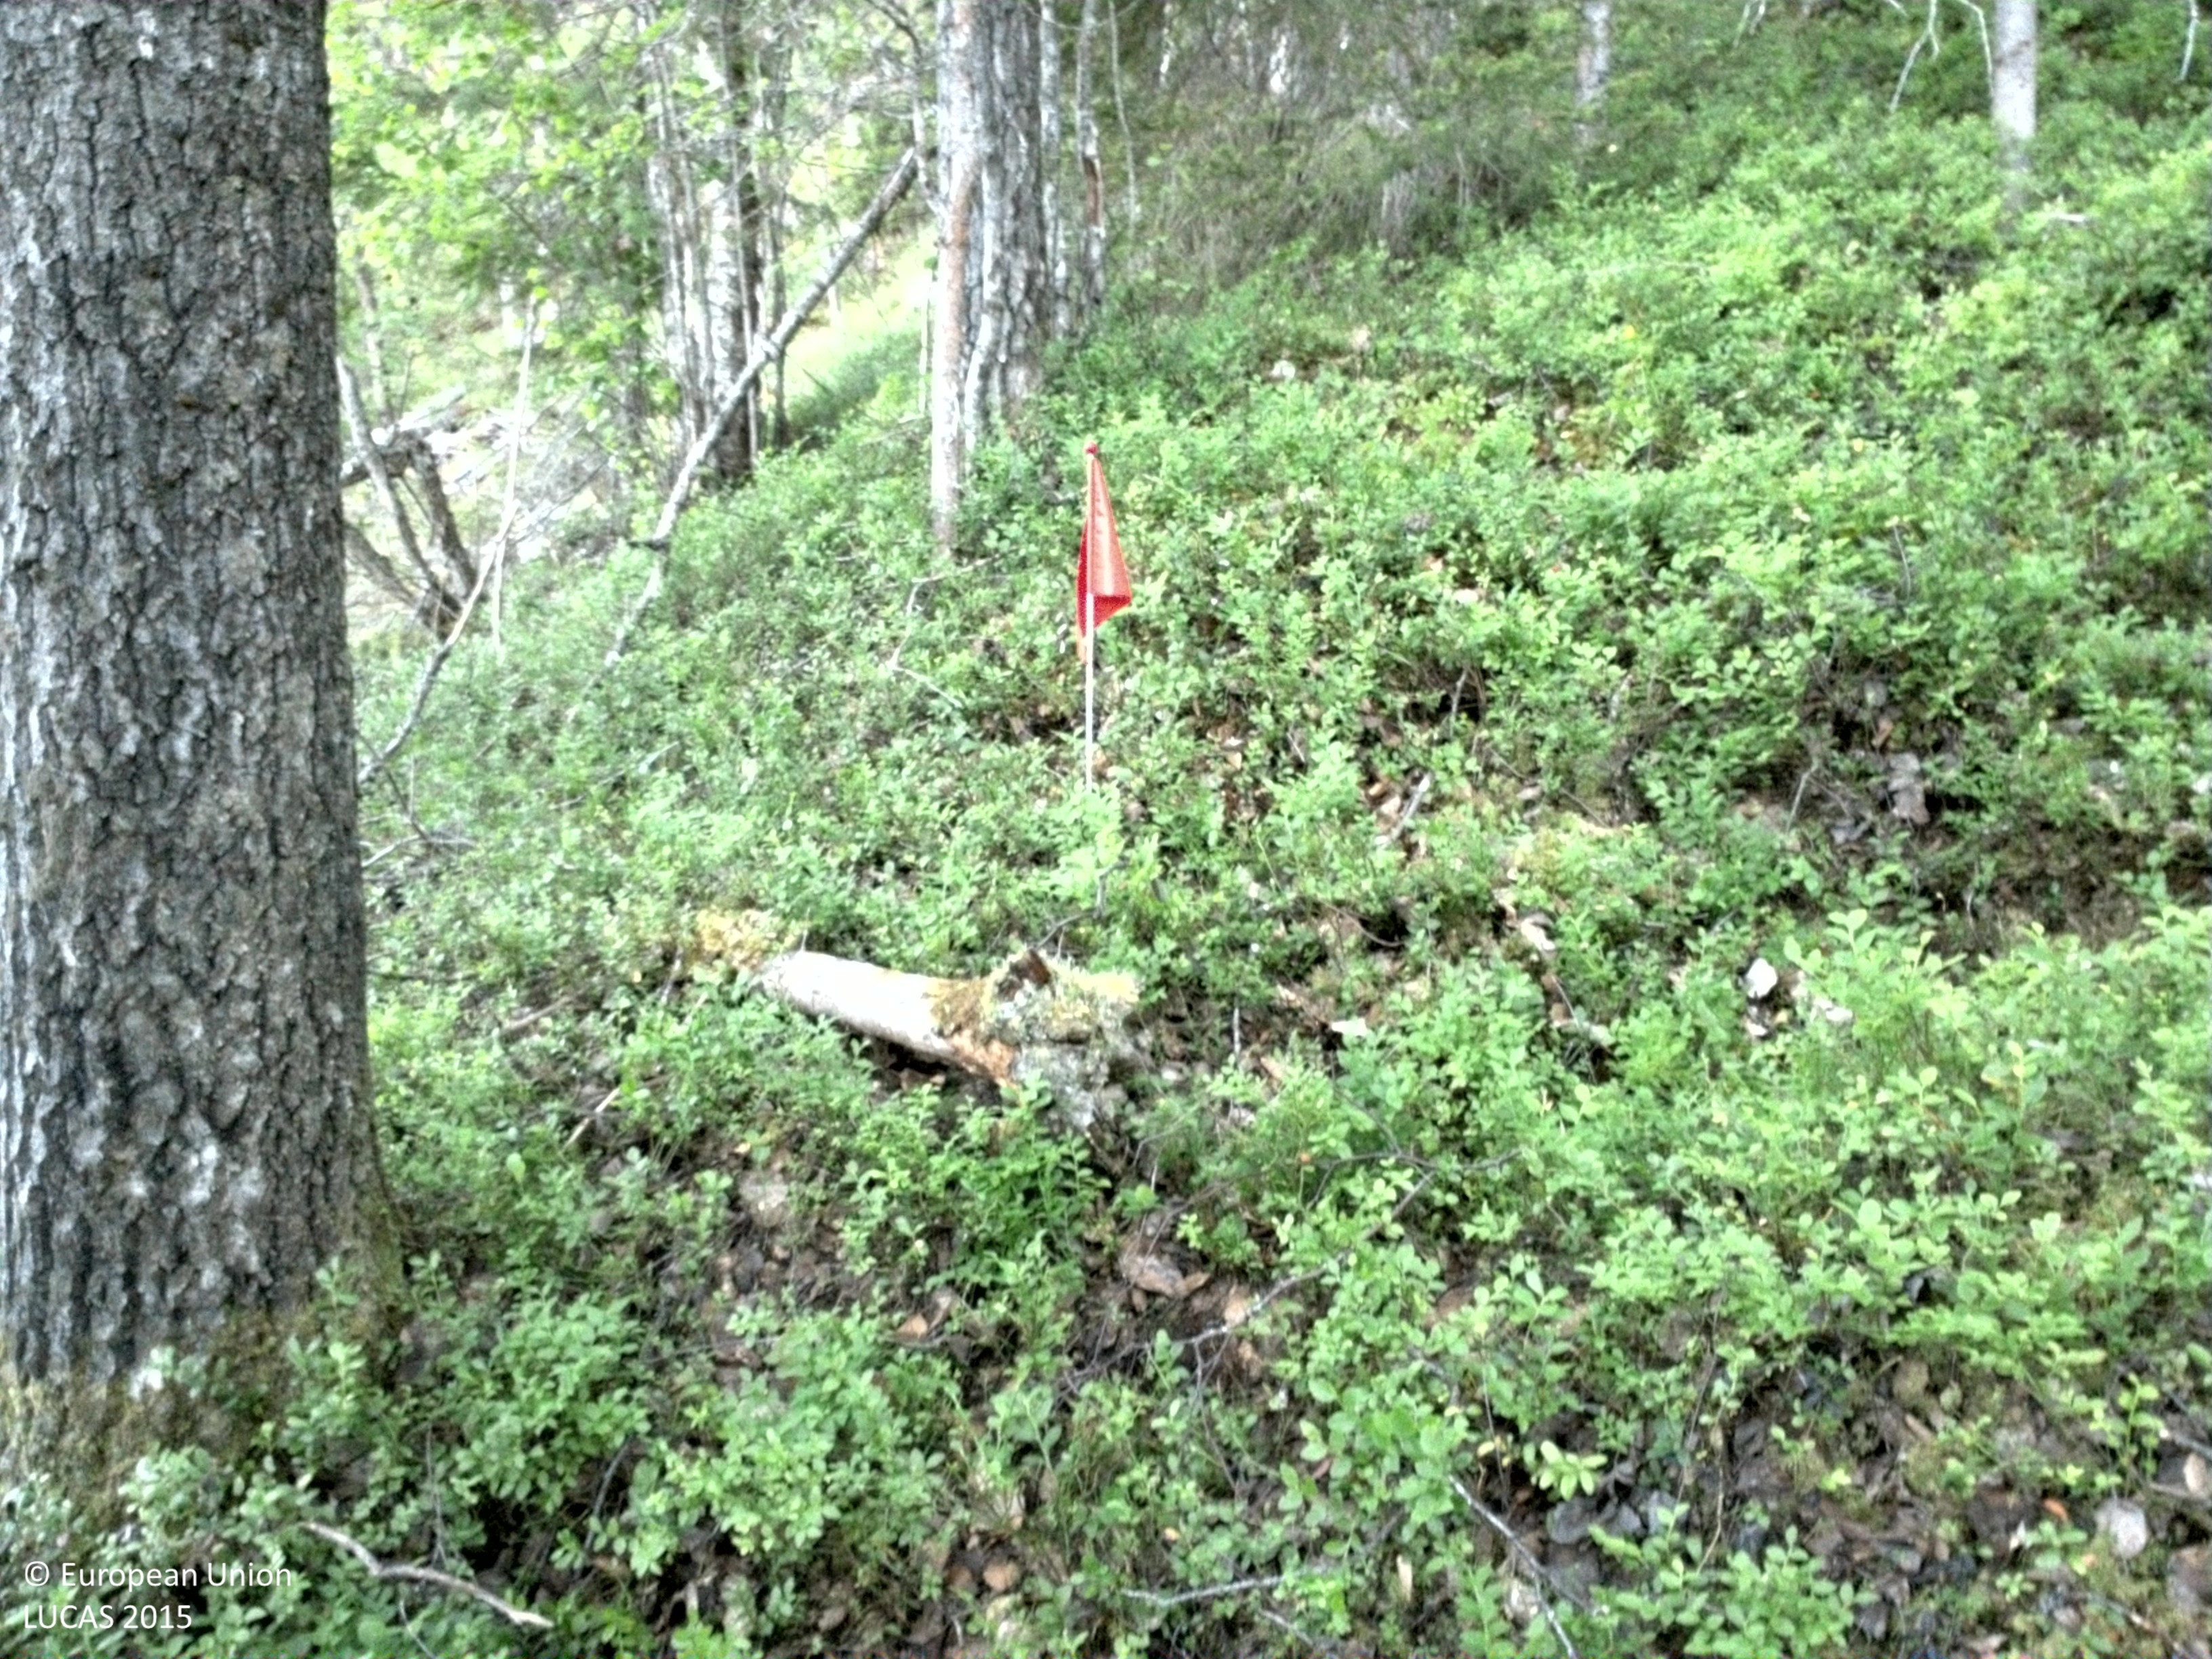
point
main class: Woodland
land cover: Broadleaved woodland
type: hemiboreal forest and nemoral coniferous forest and mixed broadleaved-coniferous forest
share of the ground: 25 - 50 %
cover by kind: shrubs 50 %, broadleaved forest trees 40 %, coniferous forest trees 5 %, consolidated bare surface 5 %
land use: Amenities, museums, leisure
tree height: < 5 m
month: August
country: SE
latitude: 66.3384
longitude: 20.6995
